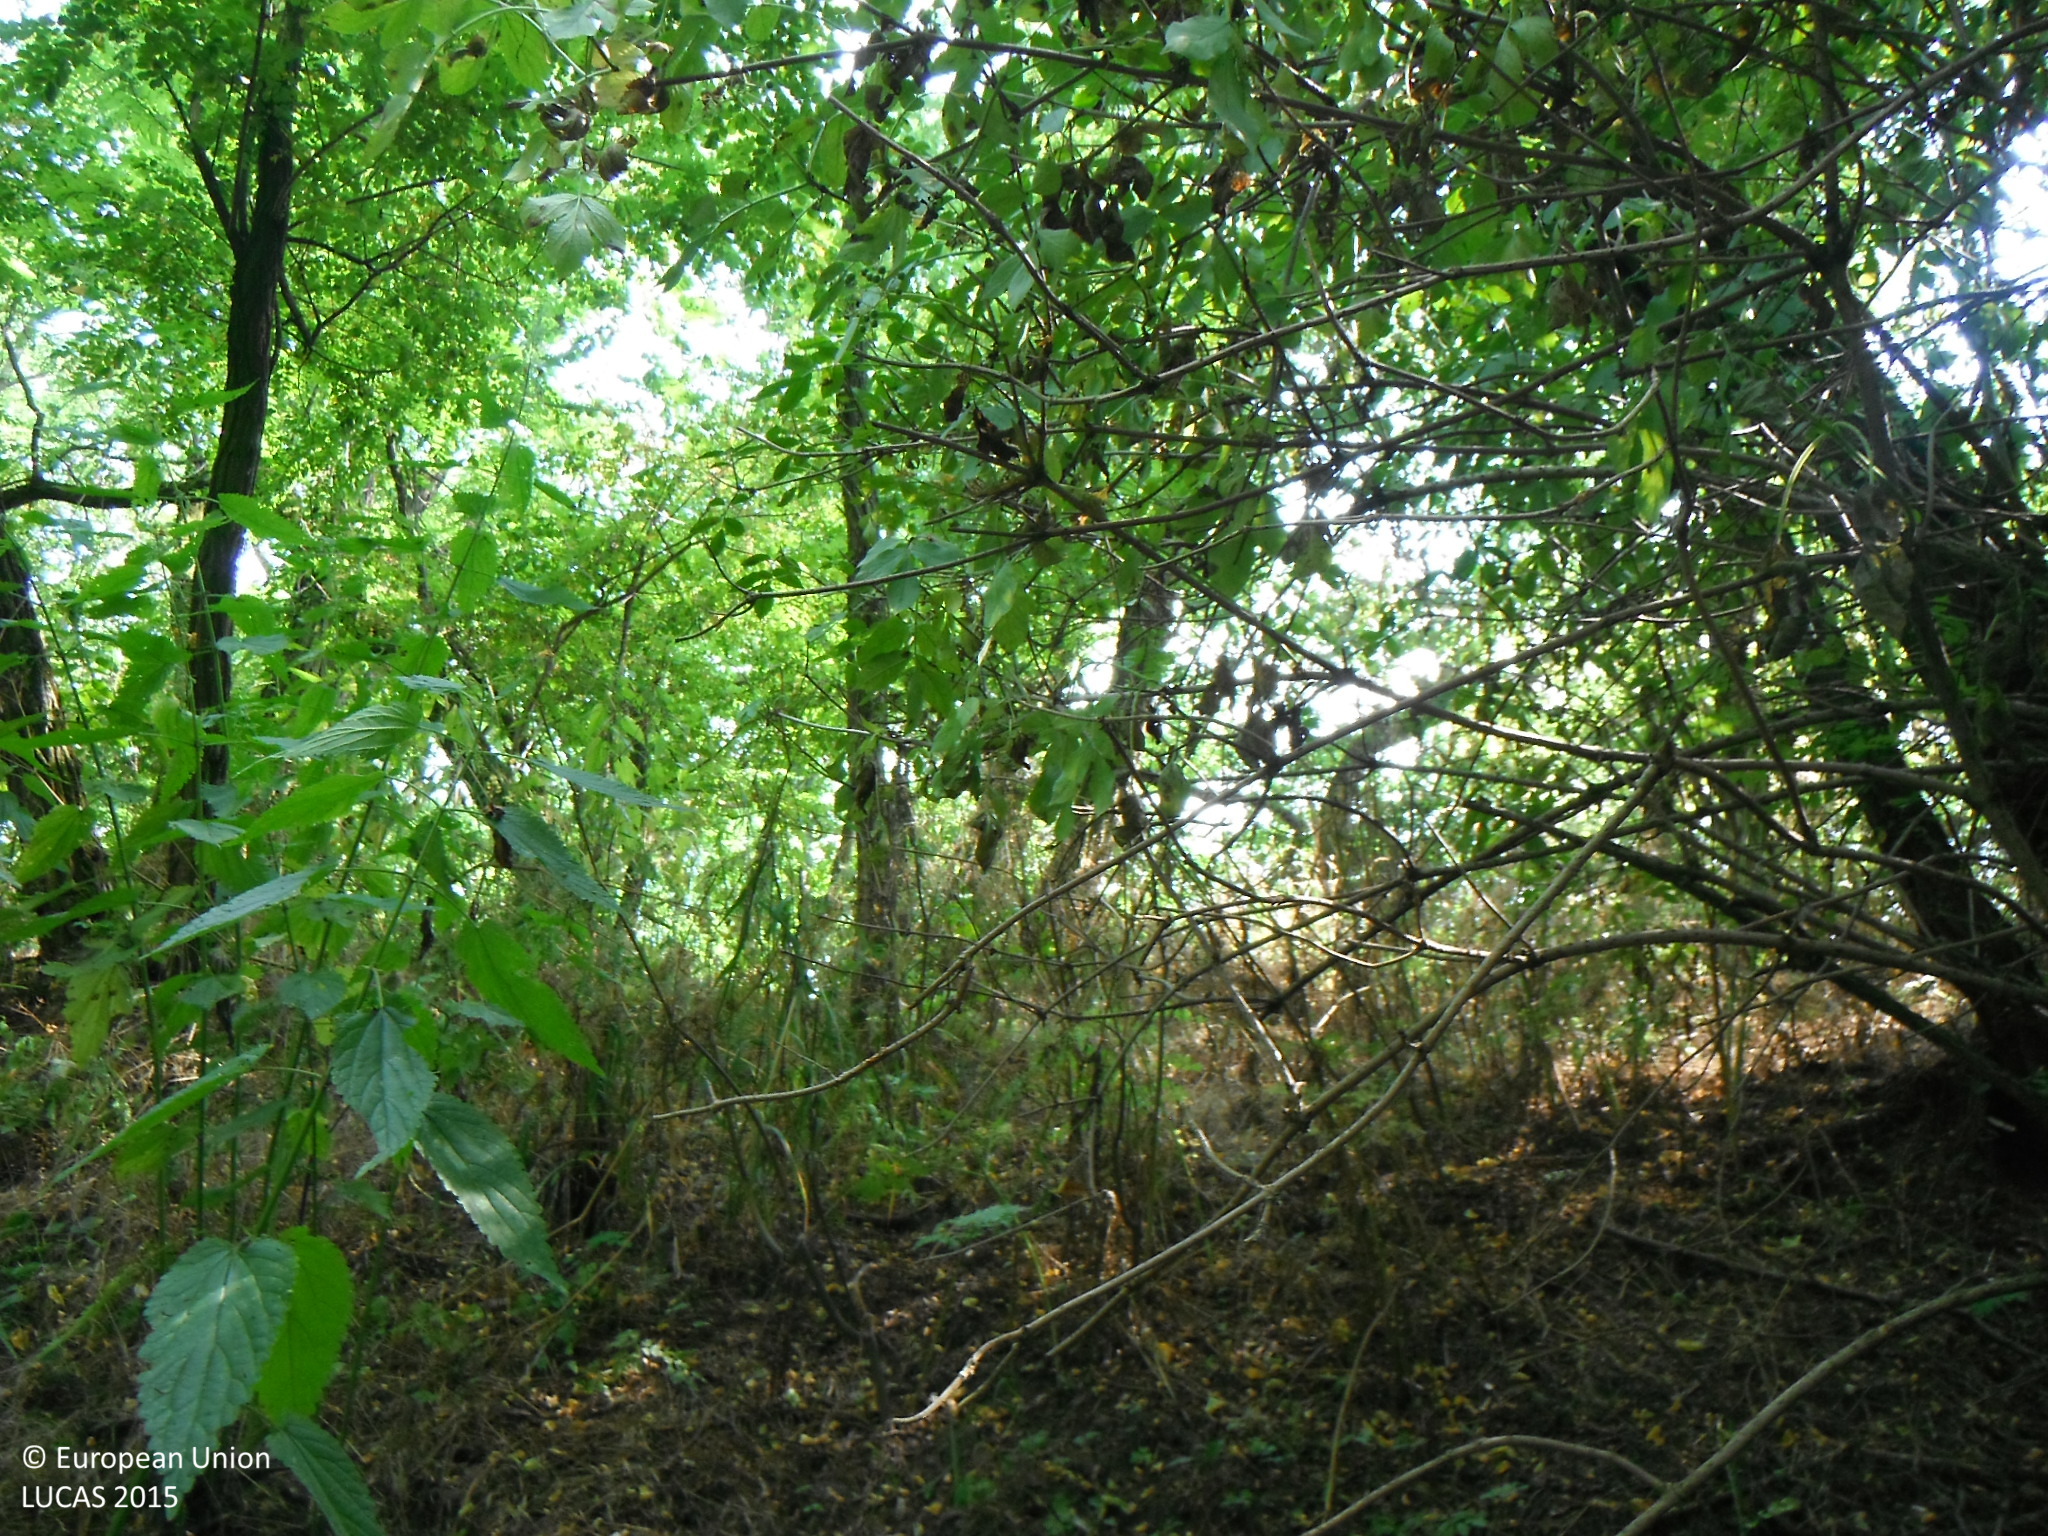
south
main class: Woodland
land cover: Broadleaved woodland
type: exotic forest
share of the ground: > 75 %
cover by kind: broadleaved forest trees 80 %, shrubs 10 %, herbaceous plants 10 %
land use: Forestry
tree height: > 5 m
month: July
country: SK
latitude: 48.1125
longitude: 19.1679
